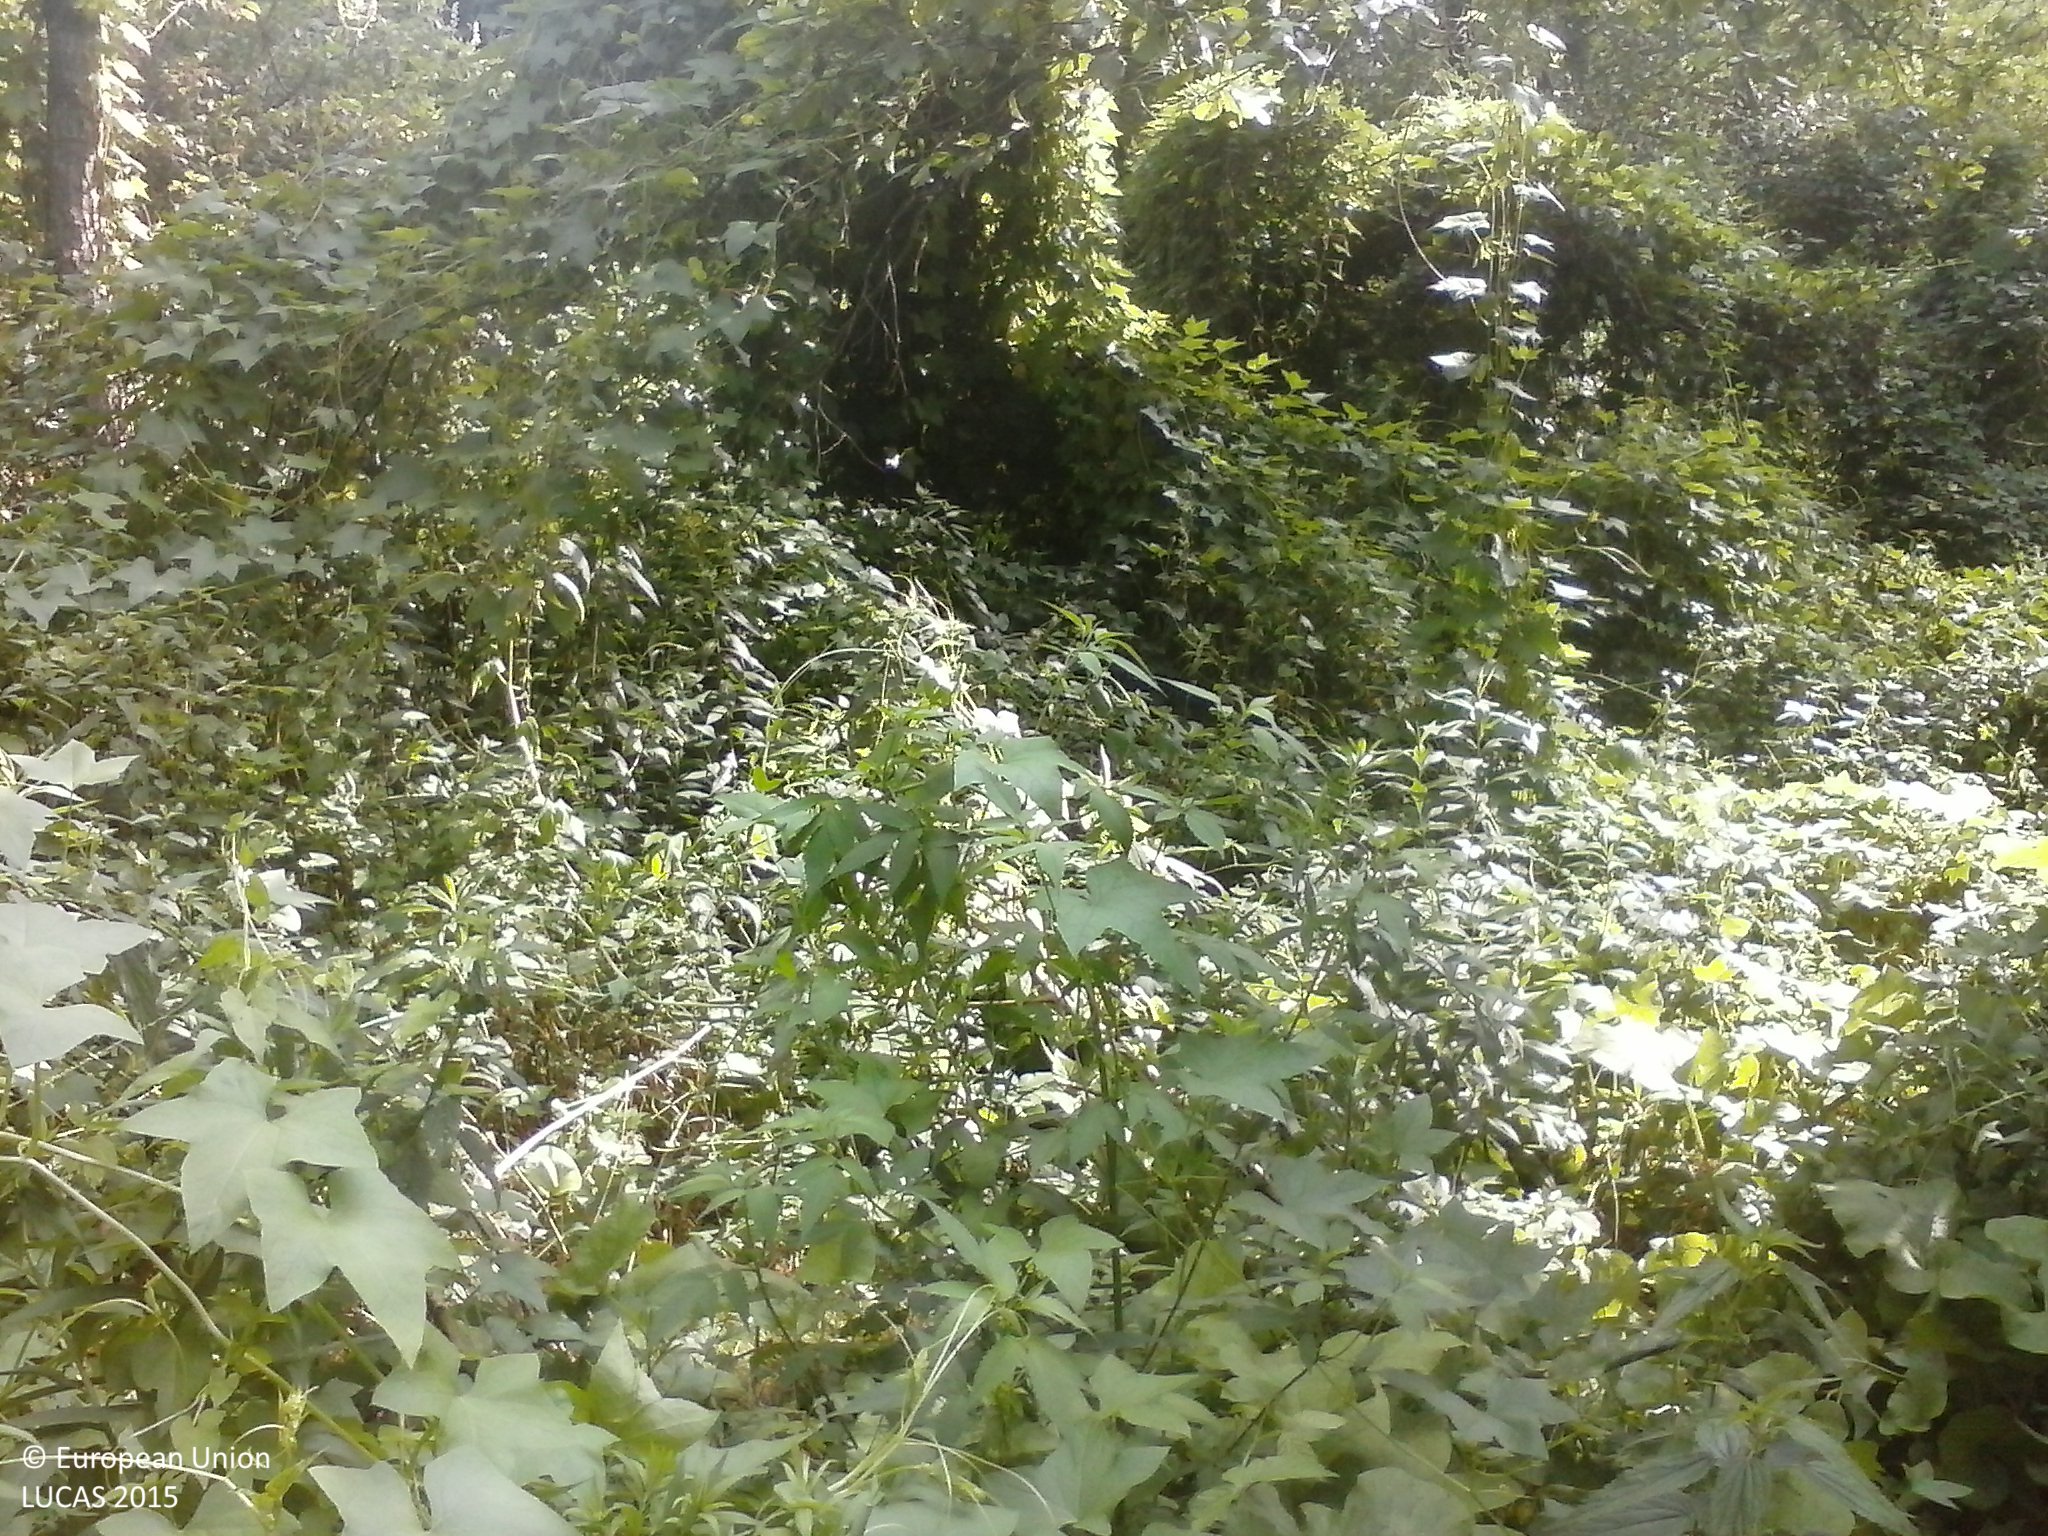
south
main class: Woodland
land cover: Broadleaved woodland
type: mesophytic deciduous forest
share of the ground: > 75 %
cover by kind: broadleaved forest trees 80 %, shrubs 10 %, herbaceous plants 10 %
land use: Forestry
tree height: > 5 m
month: July
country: HU
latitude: 45.9413
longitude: 17.5232
